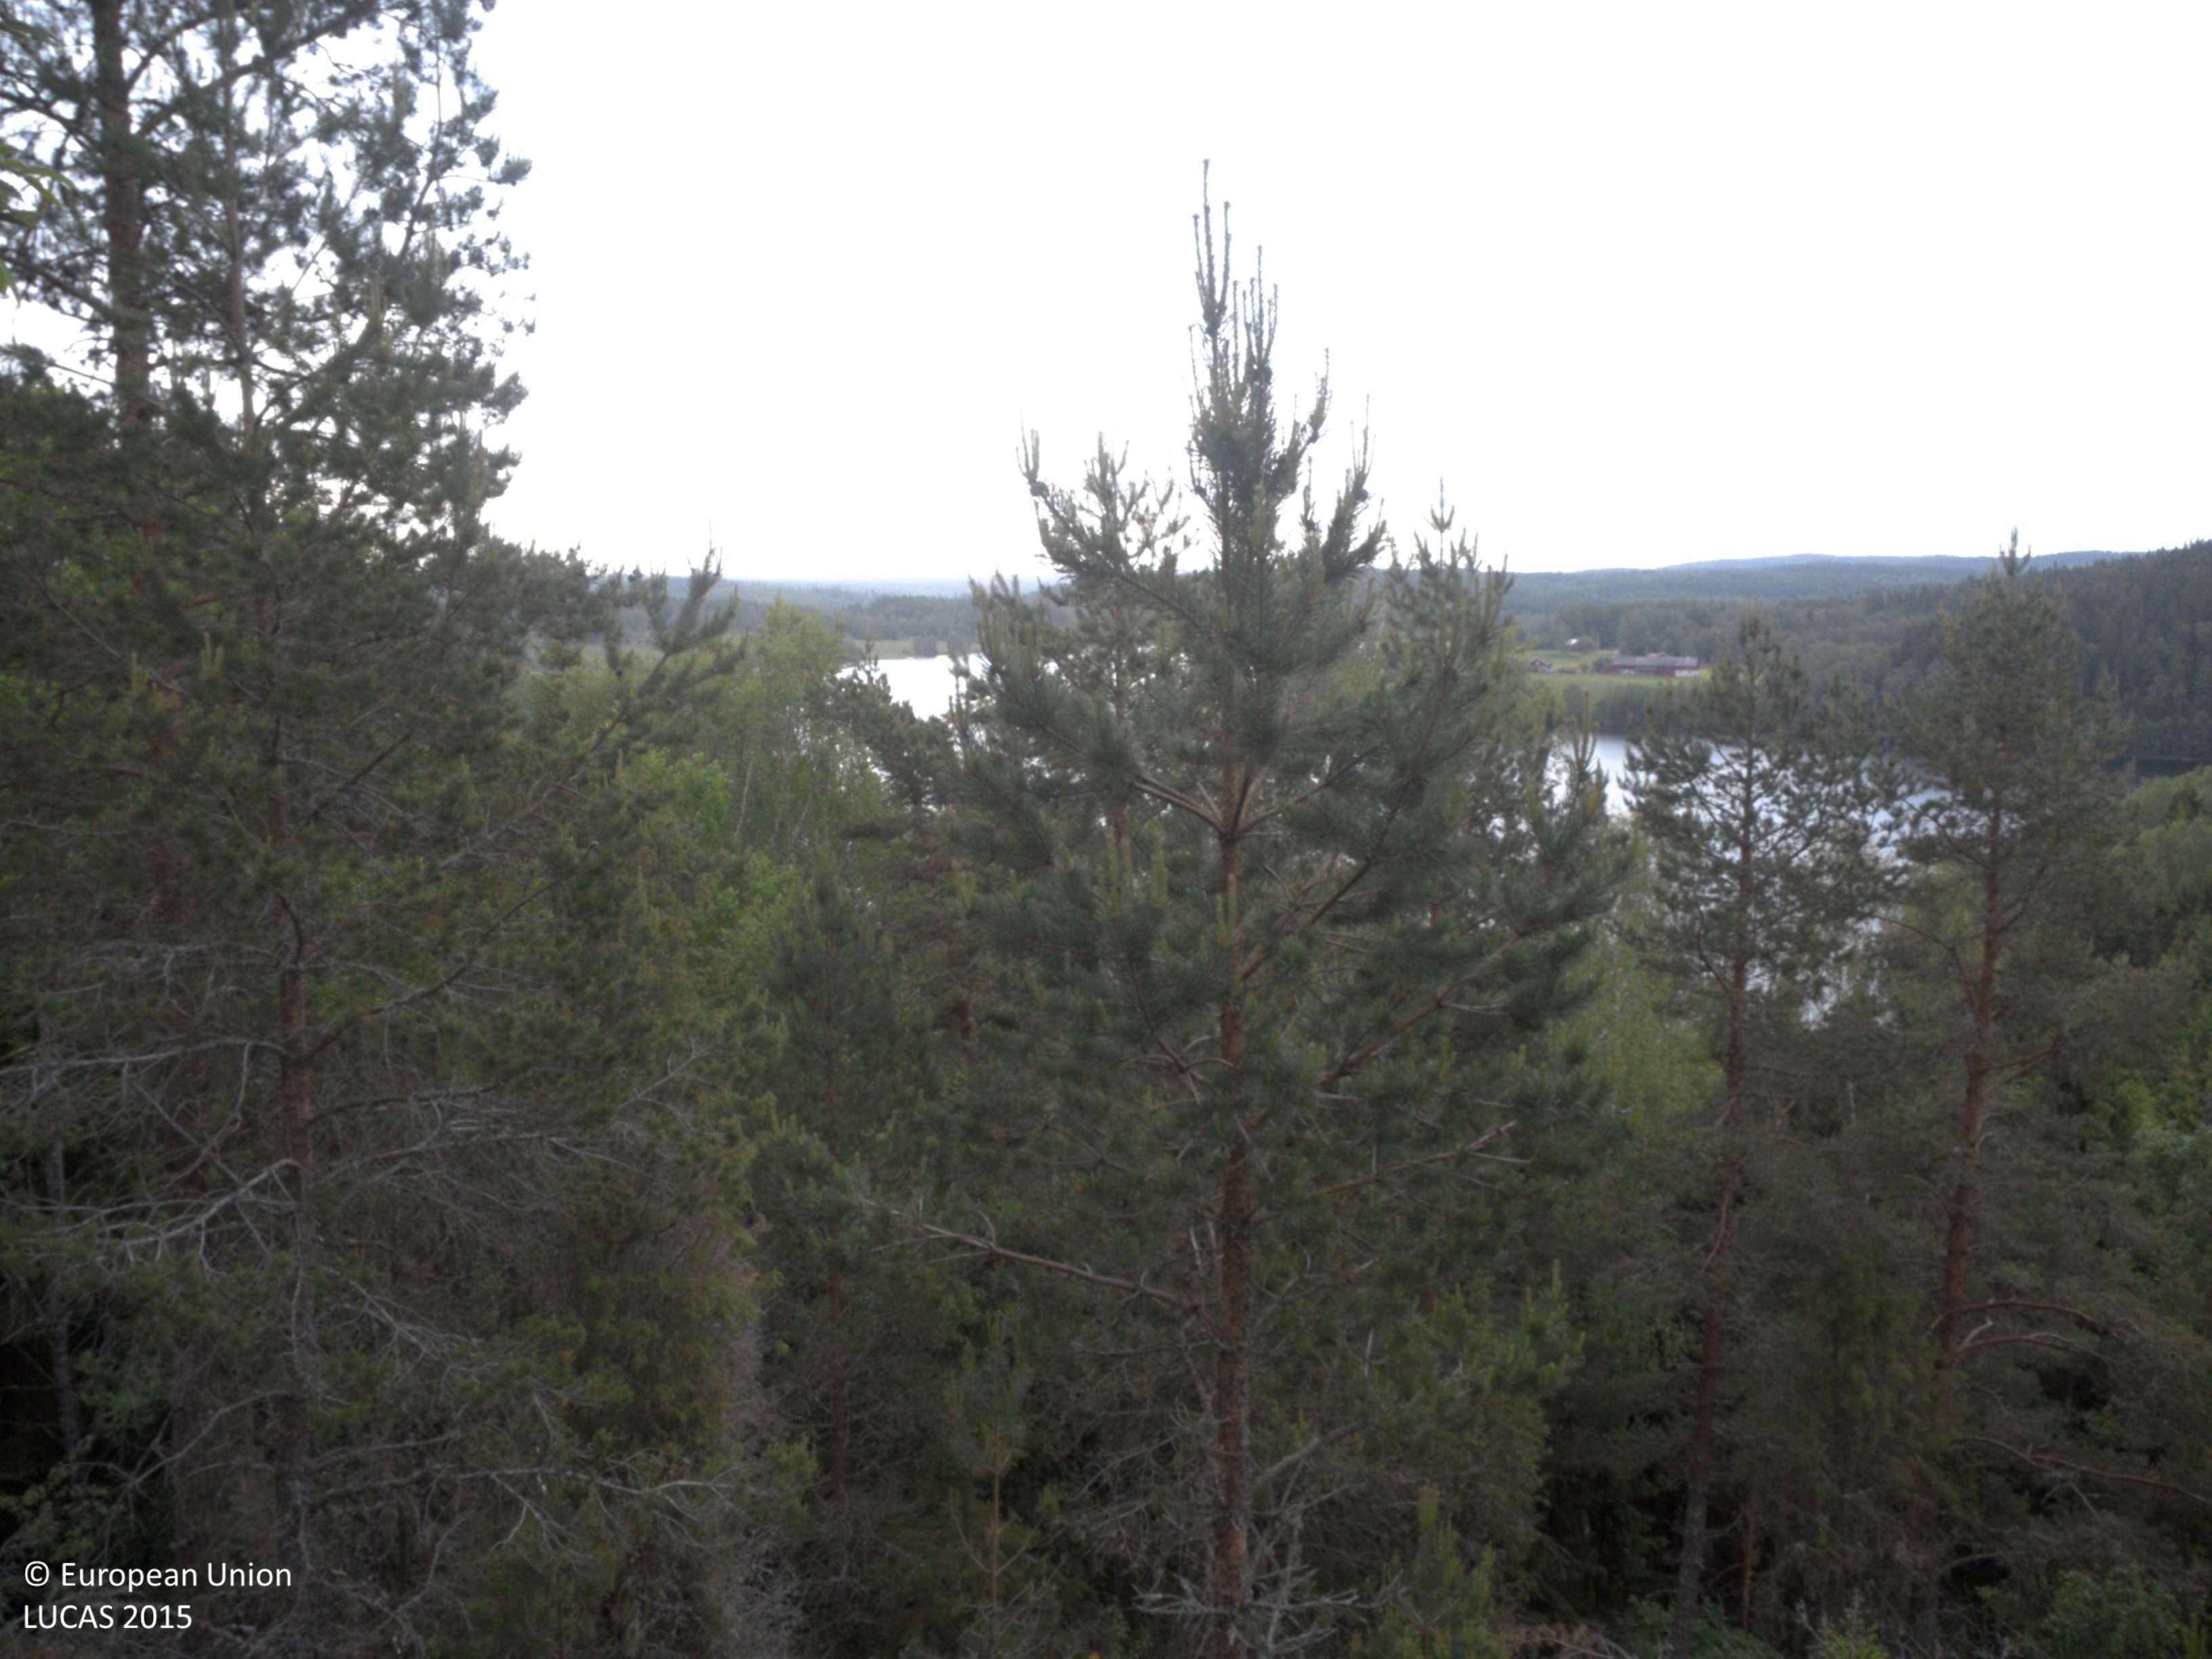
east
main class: Woodland
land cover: Pine dominated coniferous woodland
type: boreal forest
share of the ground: 25 - 50 %
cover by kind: coniferous forest trees 30 %, shrubs 25 %, herbaceous plants 15 %, lichens and mosses 15 %, consolidated bare surface 15 %
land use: Forestry
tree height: > 5 m
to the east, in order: Pine dominated coniferous woodland; Rock outcrops; Pine dominated coniferous woodland; Spruce dominated coniferous woodland; Tracks; Spruce dominated coniferous woodland; Inland fresh water bodies
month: June
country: SE
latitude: 59.1947
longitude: 11.9734
